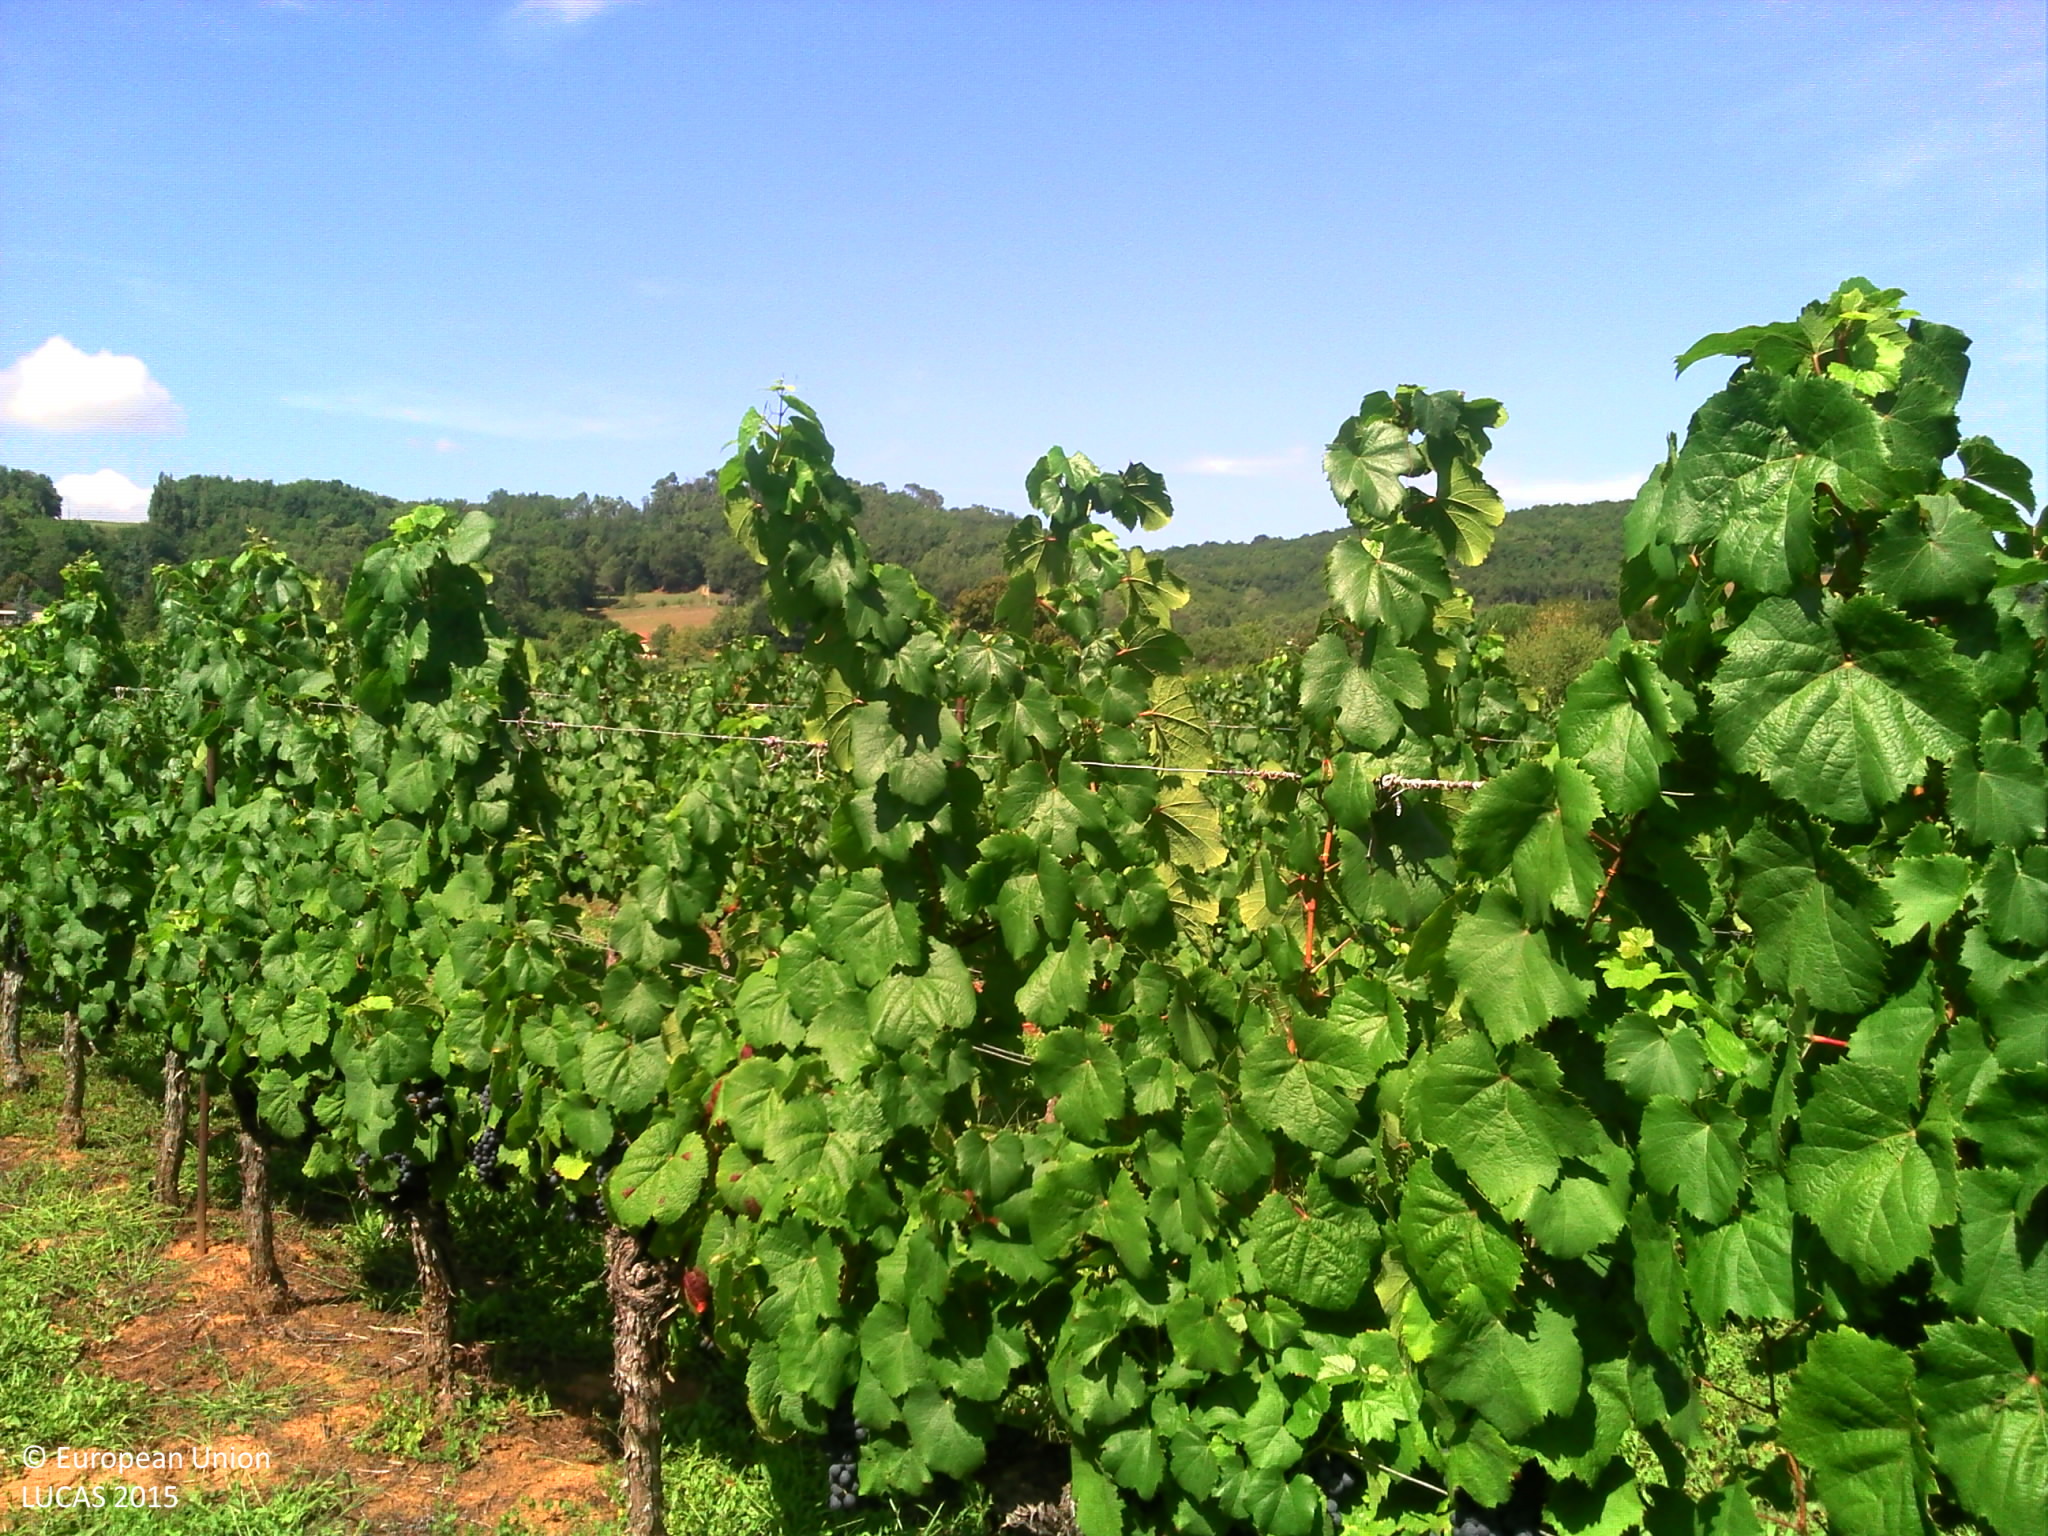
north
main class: Cropland
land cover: Vineyards
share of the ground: 25 - 50 %
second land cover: Grassland without tree/shrub cover
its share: 50 - 75 %
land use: Agriculture (excluding fallow land and kitchen gardens)
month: August
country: FR
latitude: 44.5181
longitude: 1.1772
